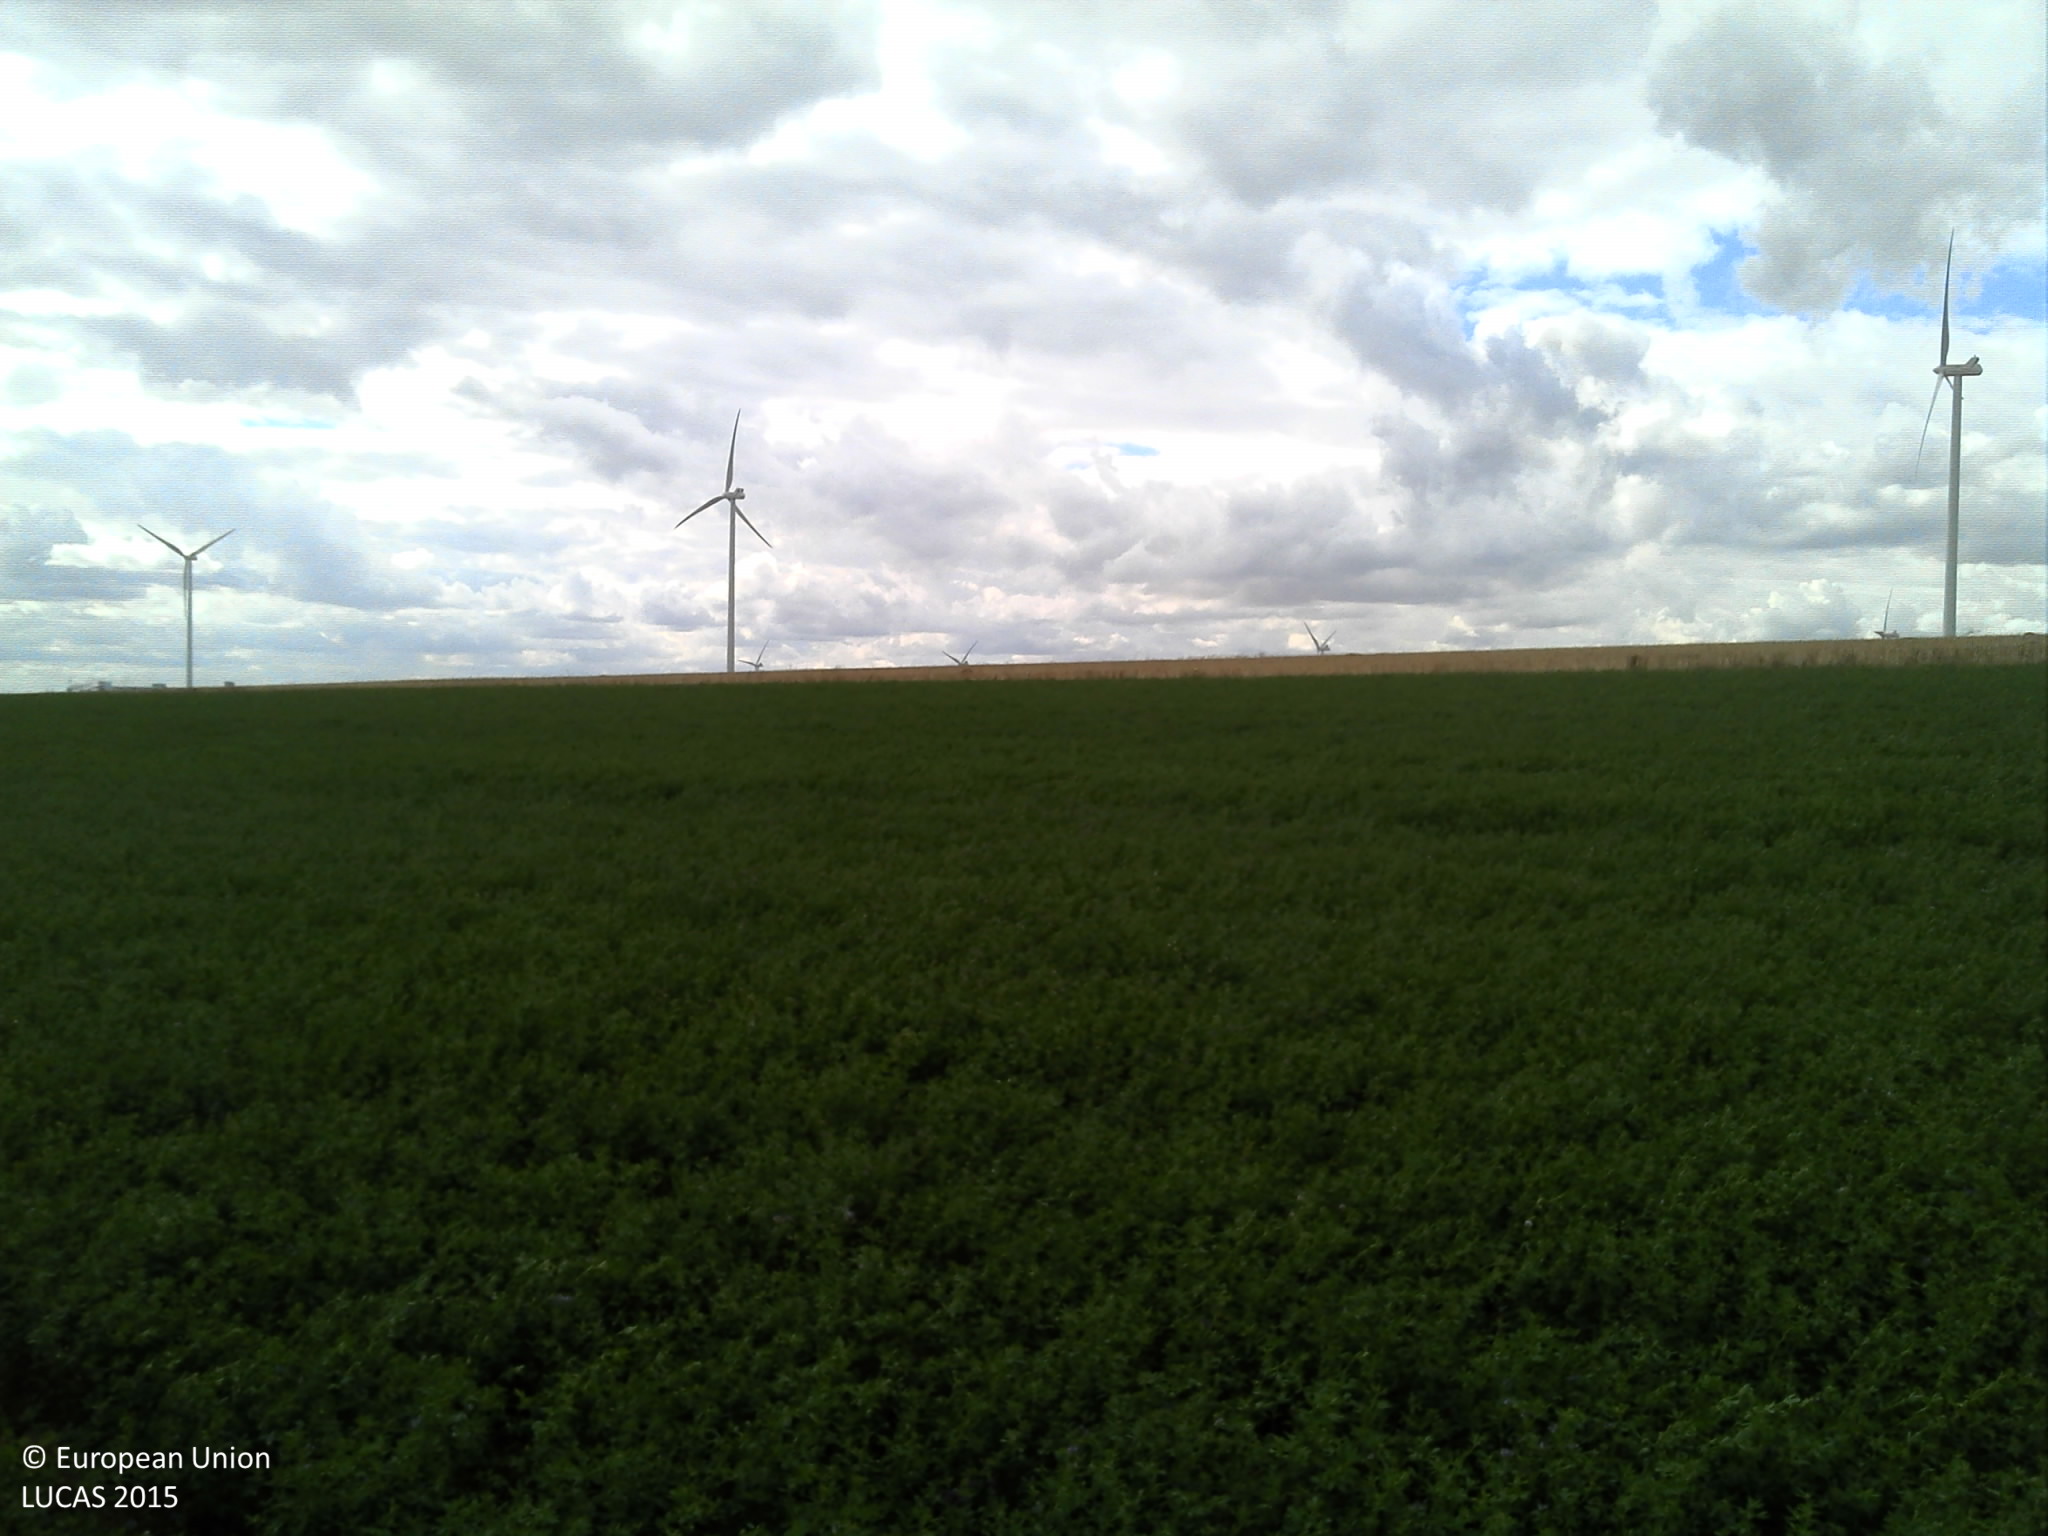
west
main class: Cropland
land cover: Lucerne
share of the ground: > 75 %
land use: Agriculture (excluding fallow land and kitchen gardens)
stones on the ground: < 10 %
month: July
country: FR
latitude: 49.4218
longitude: 4.5234
